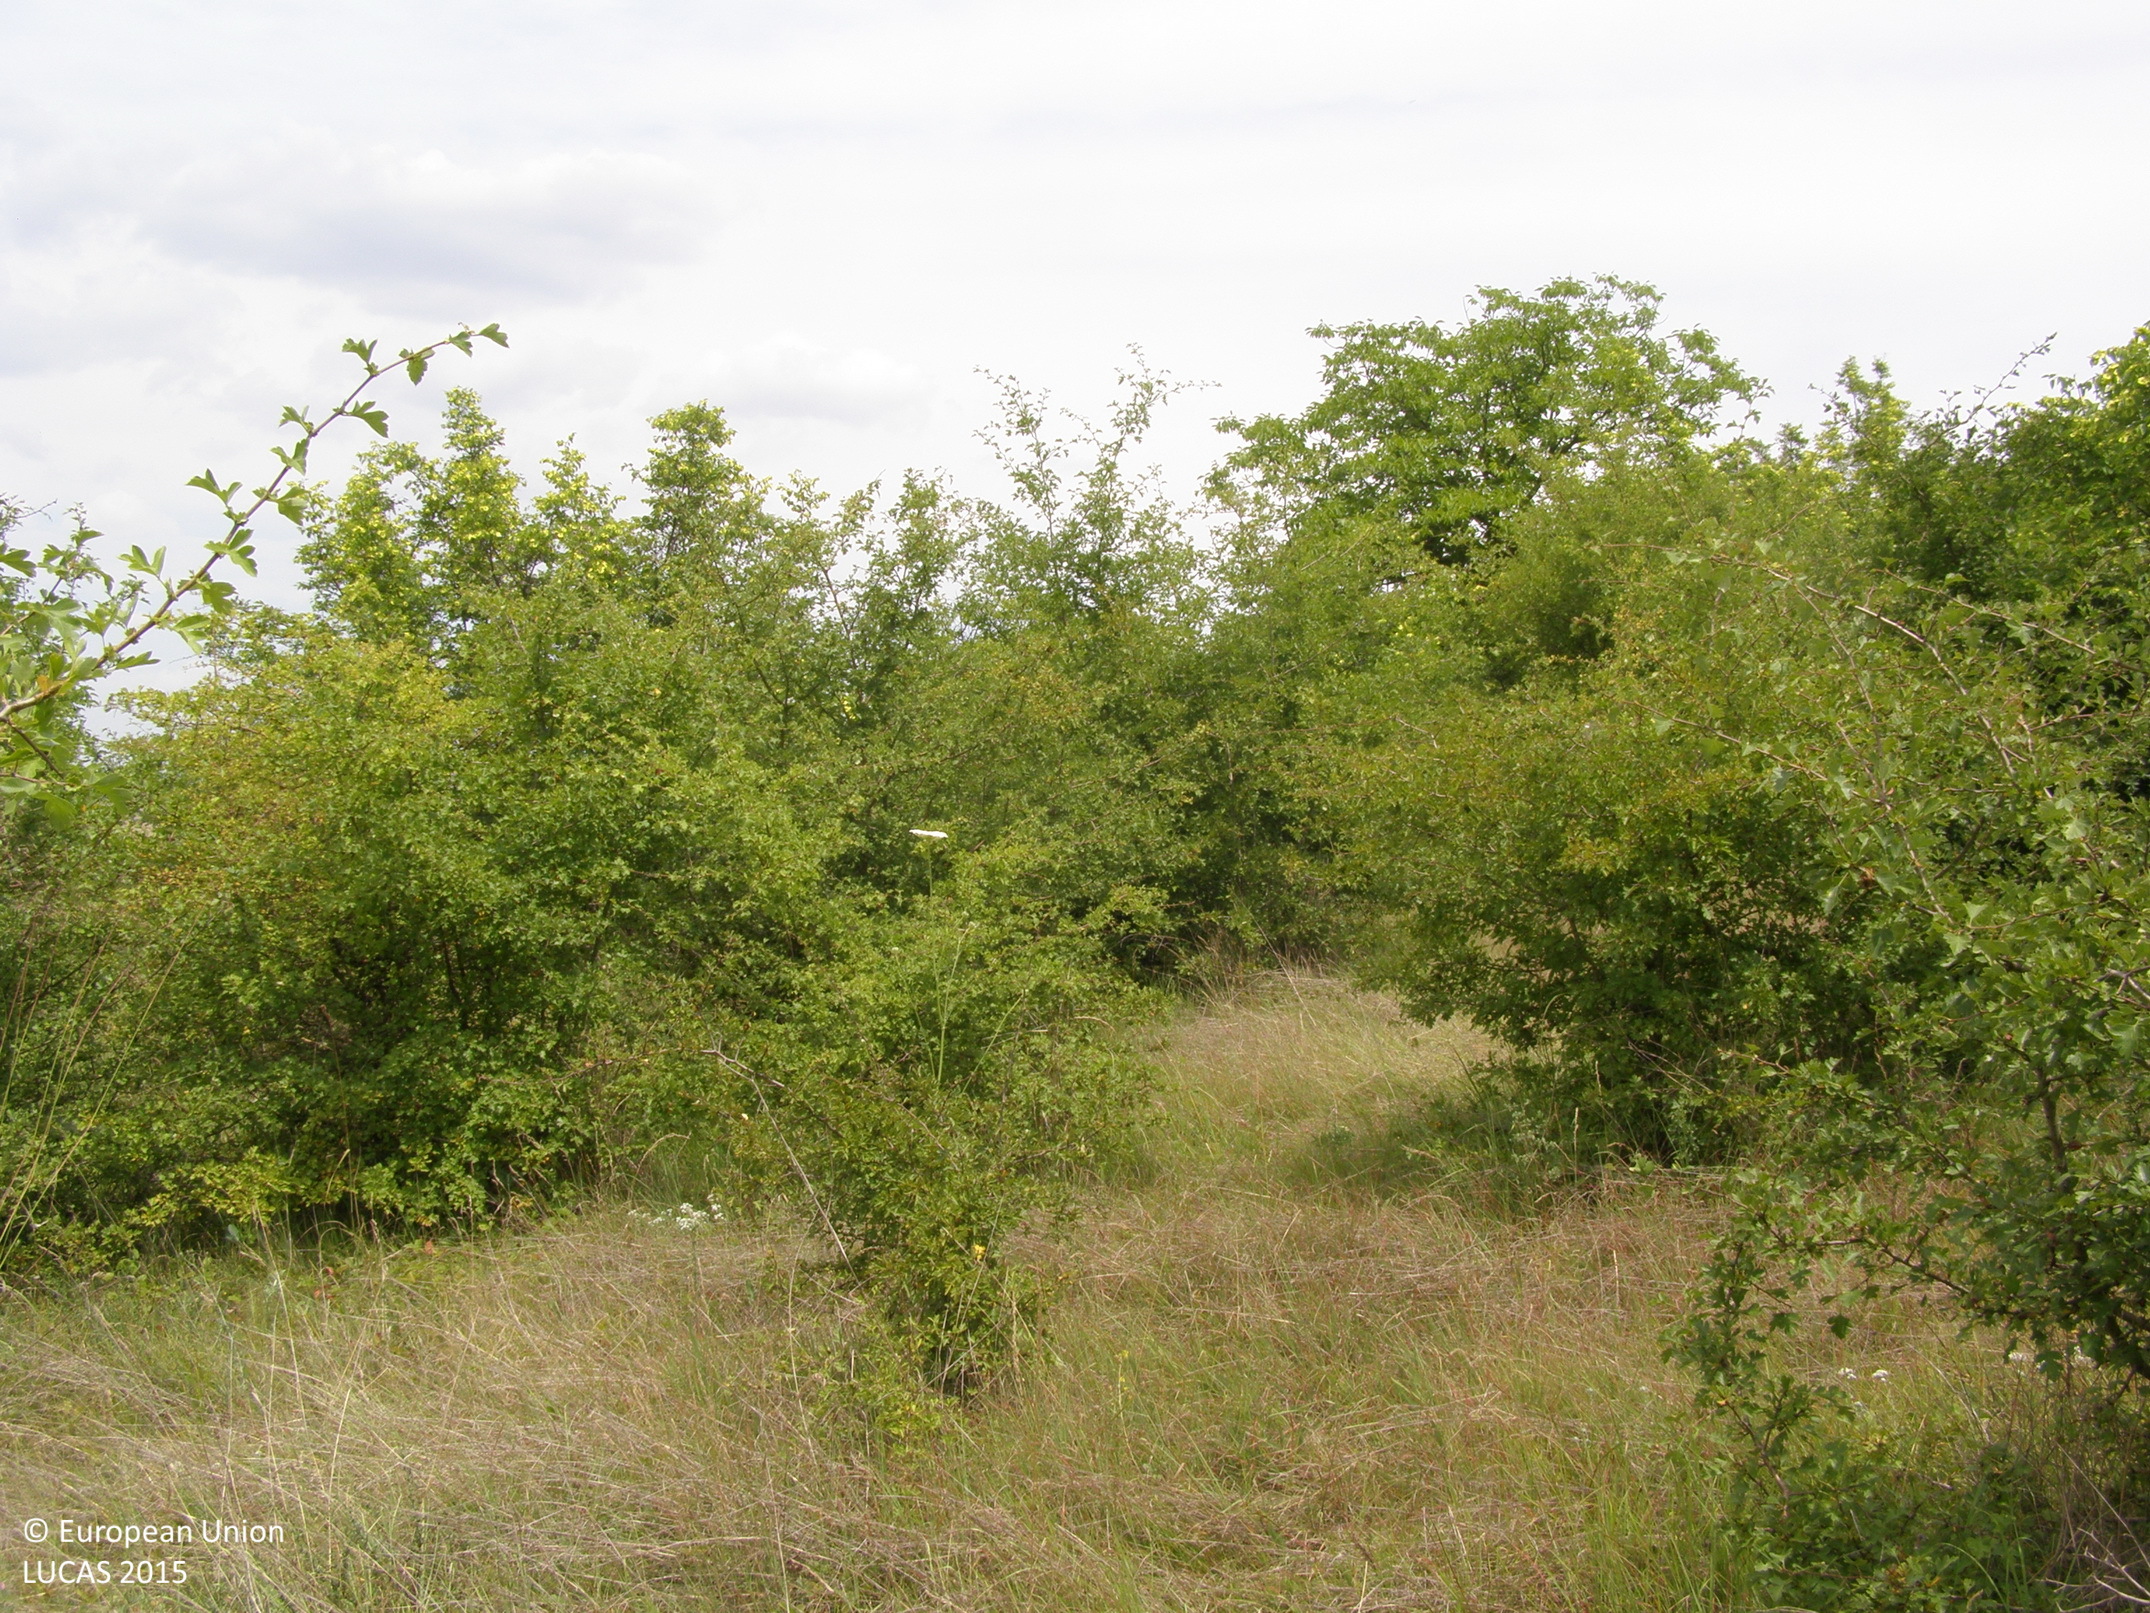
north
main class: Grassland
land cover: Grassland with sparse tree/shrub cover
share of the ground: > 75 %
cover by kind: herbaceous plants 85 %, shrubs 10 %, broadleaved forest trees 5 %
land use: Abandoned areas
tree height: < 5 m
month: July
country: BG
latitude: 43.2668
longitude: 27.1069
